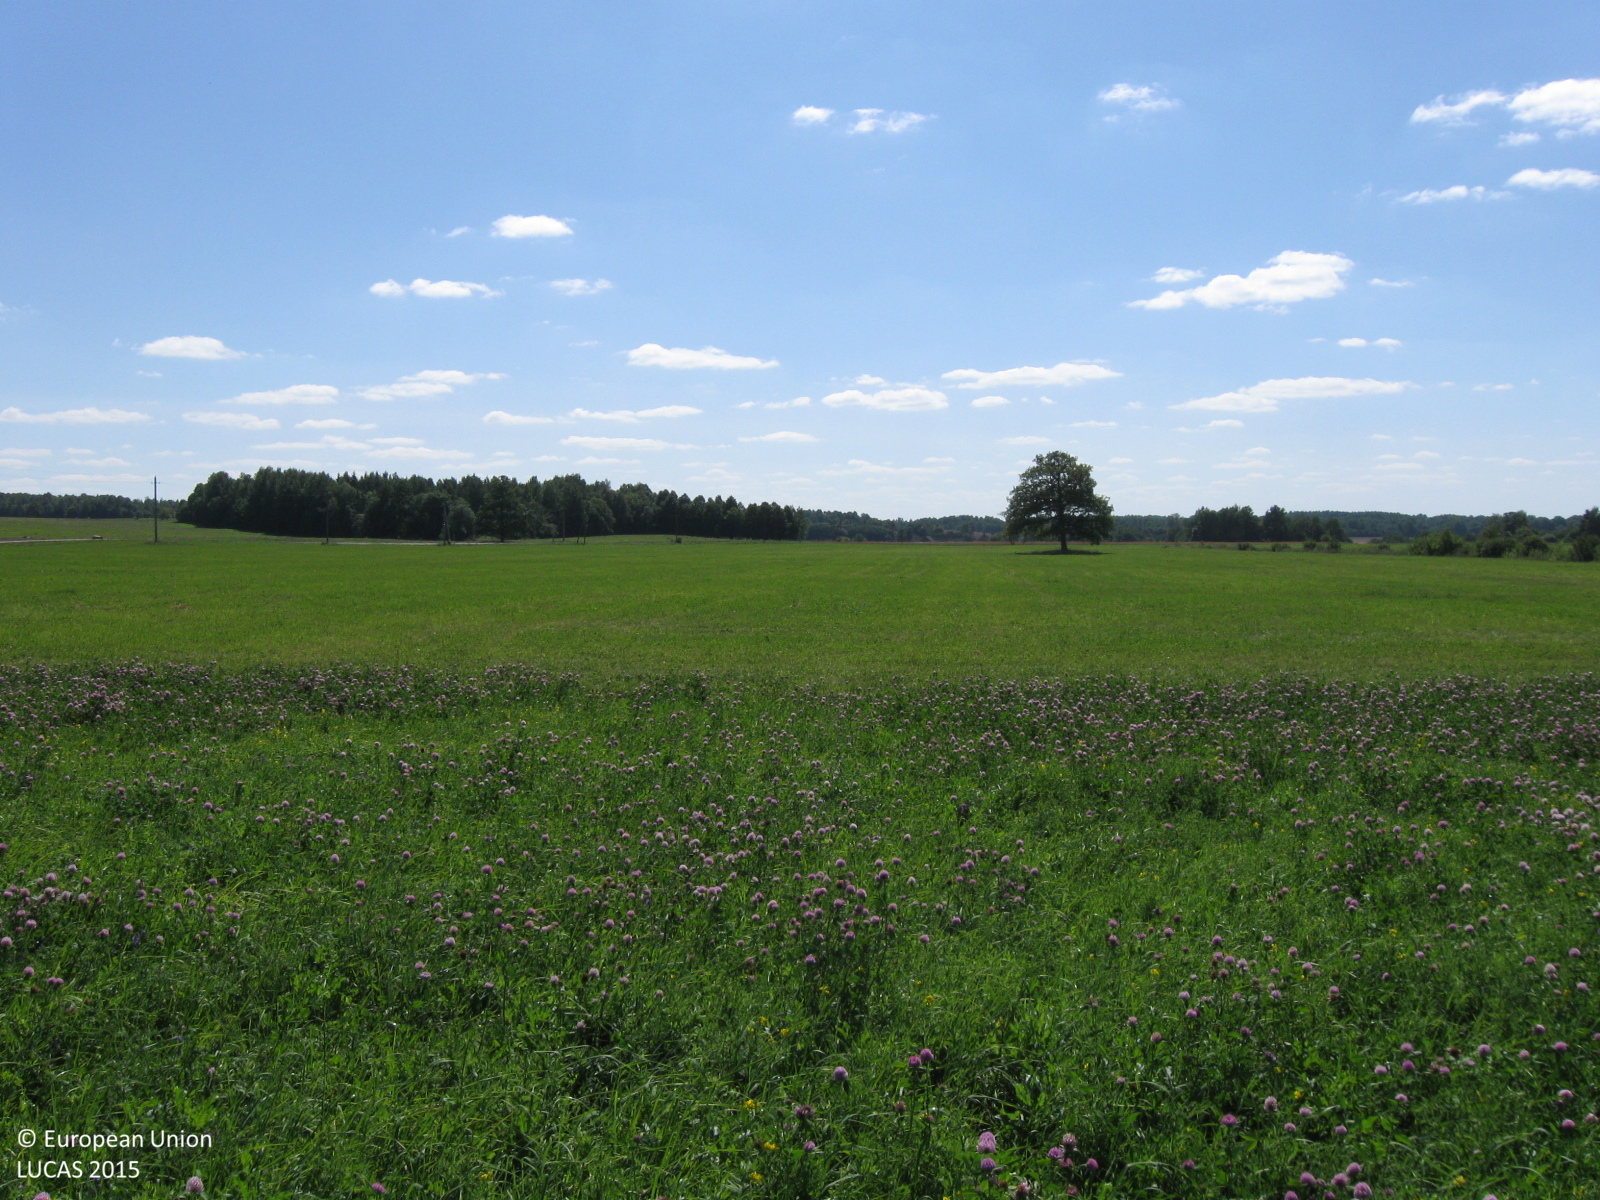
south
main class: Cropland
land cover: Other leguminous and mixtures for fodder
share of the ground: > 75 %
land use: Agriculture (excluding fallow land and kitchen gardens)
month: August
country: LT
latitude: 55.5454
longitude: 22.5990
